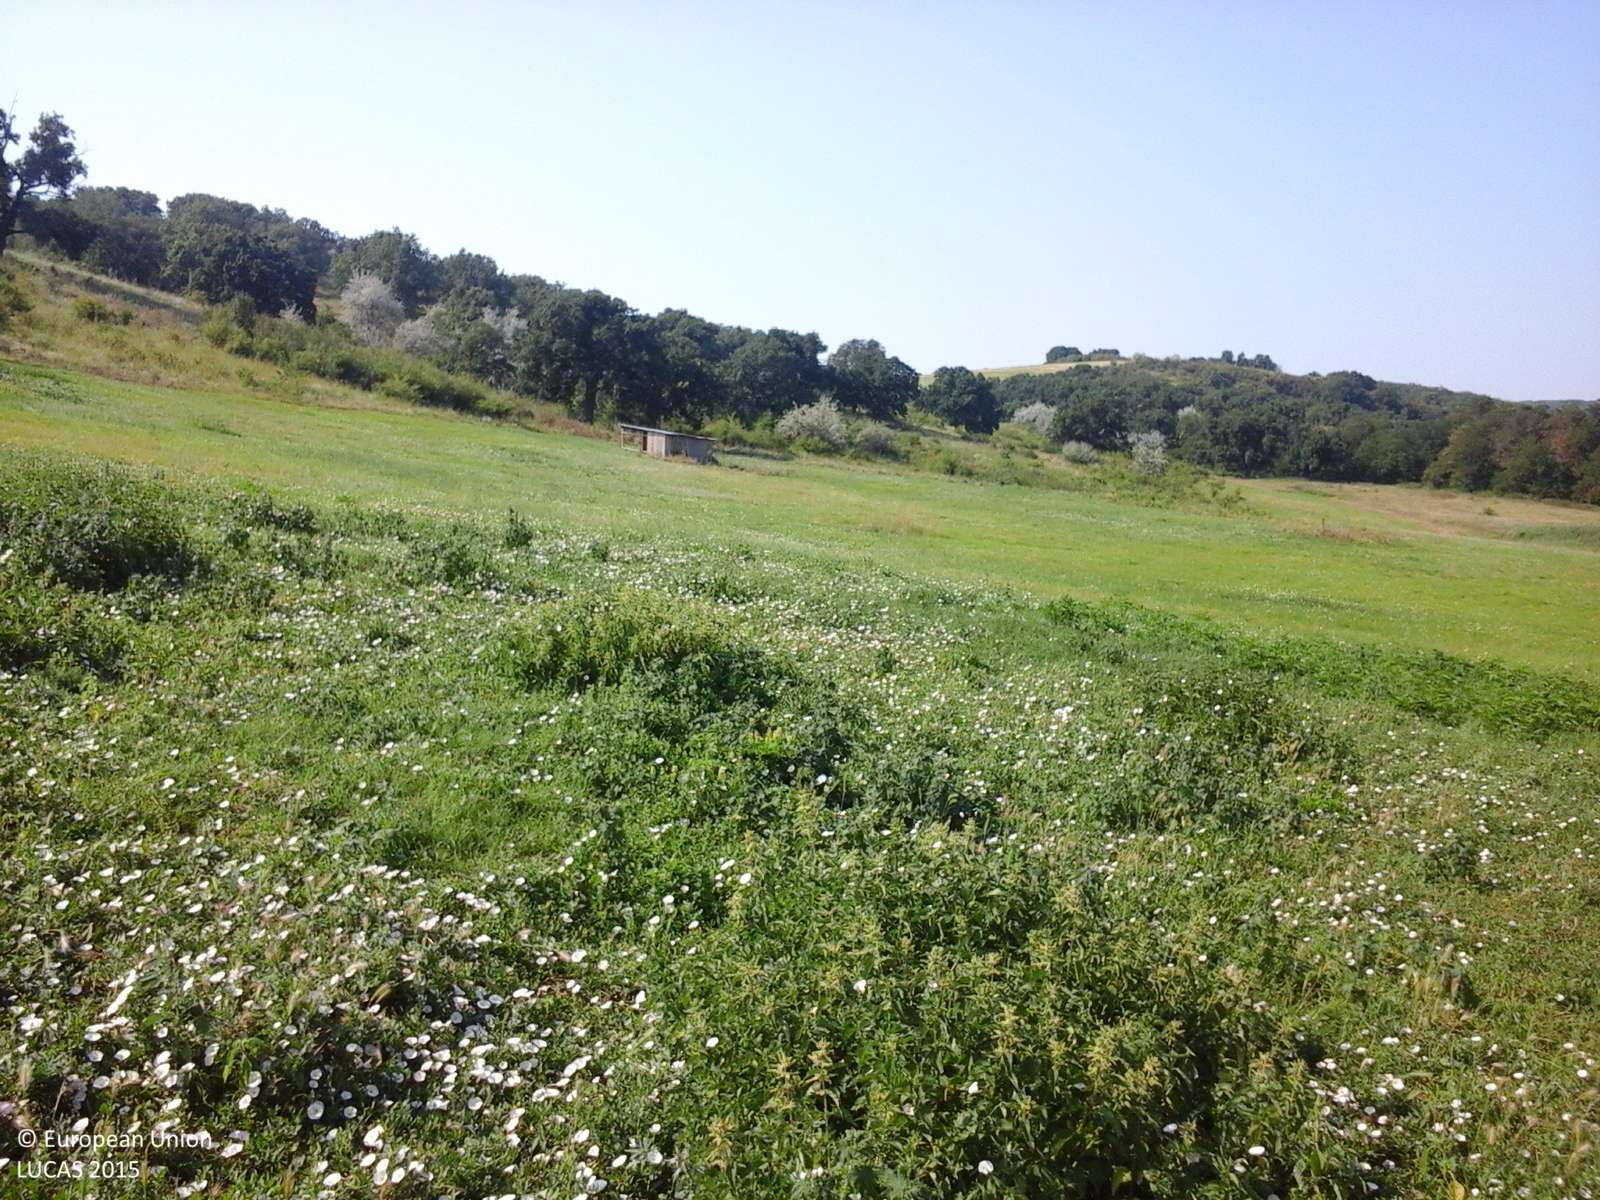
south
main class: Grassland
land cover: Grassland without tree/shrub cover
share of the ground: > 75 %
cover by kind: herbaceous plants 100 %
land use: Agriculture (excluding fallow land and kitchen gardens)
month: July
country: RO
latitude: 45.9788
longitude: 28.0522
